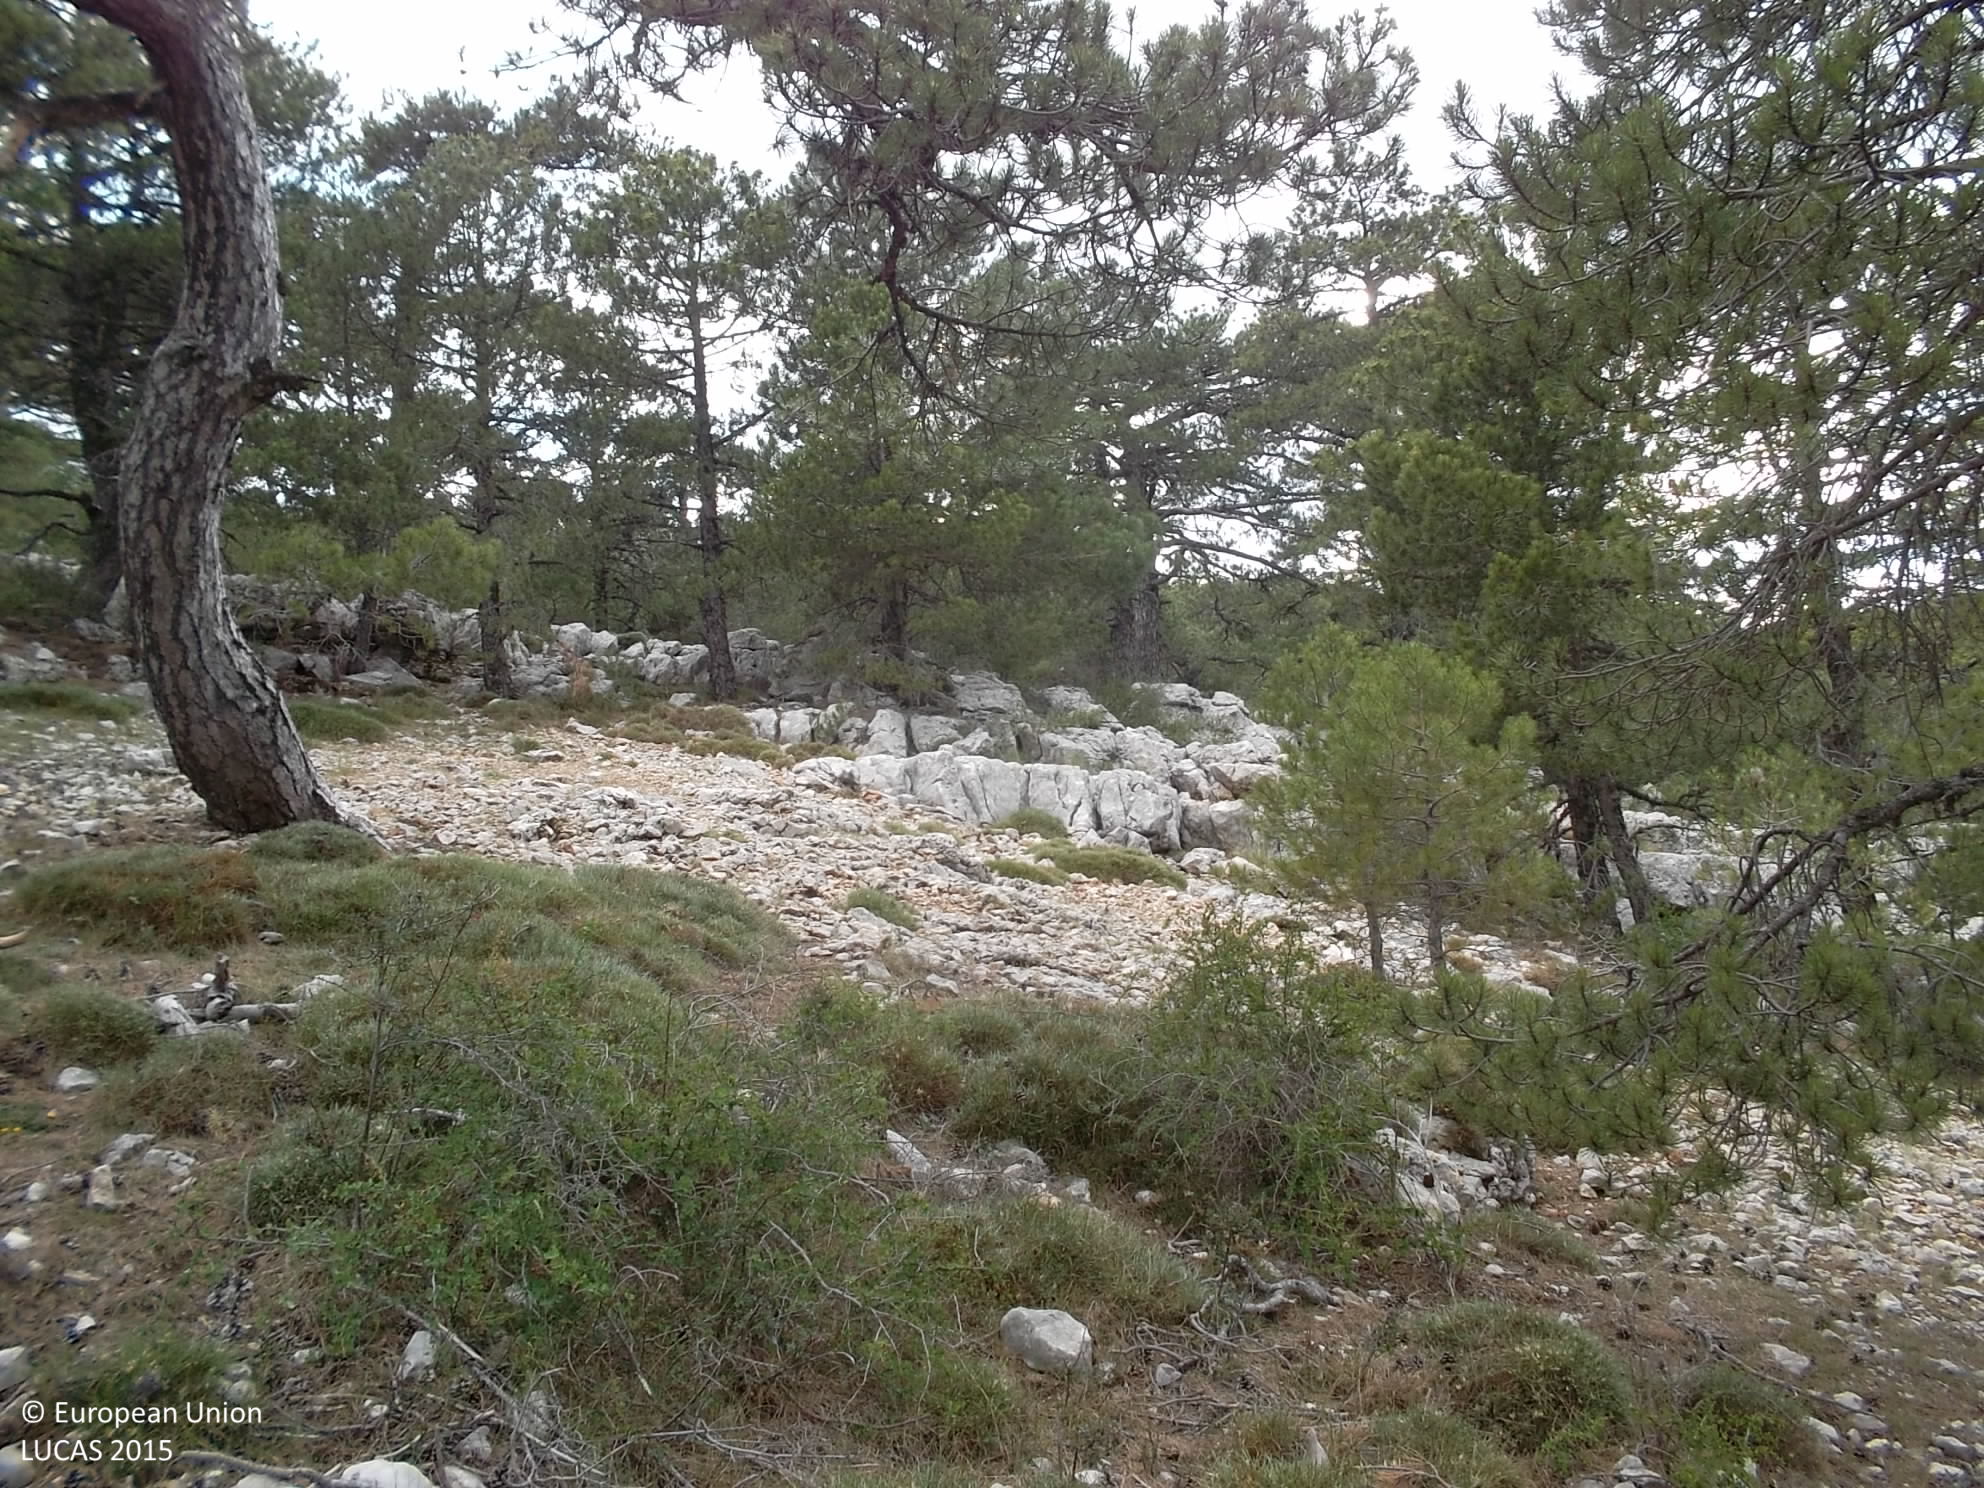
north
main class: Woodland
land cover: Pine dominated coniferous woodland
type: coniferous forest of the mediterranean region
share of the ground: 50 - 75 %
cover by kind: coniferous forest trees 60 %, herbaceous plants 20 %, consolidated bare surface 20 %
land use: Forestry
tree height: > 5 m
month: June
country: ES
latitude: 37.7902
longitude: -2.9726
